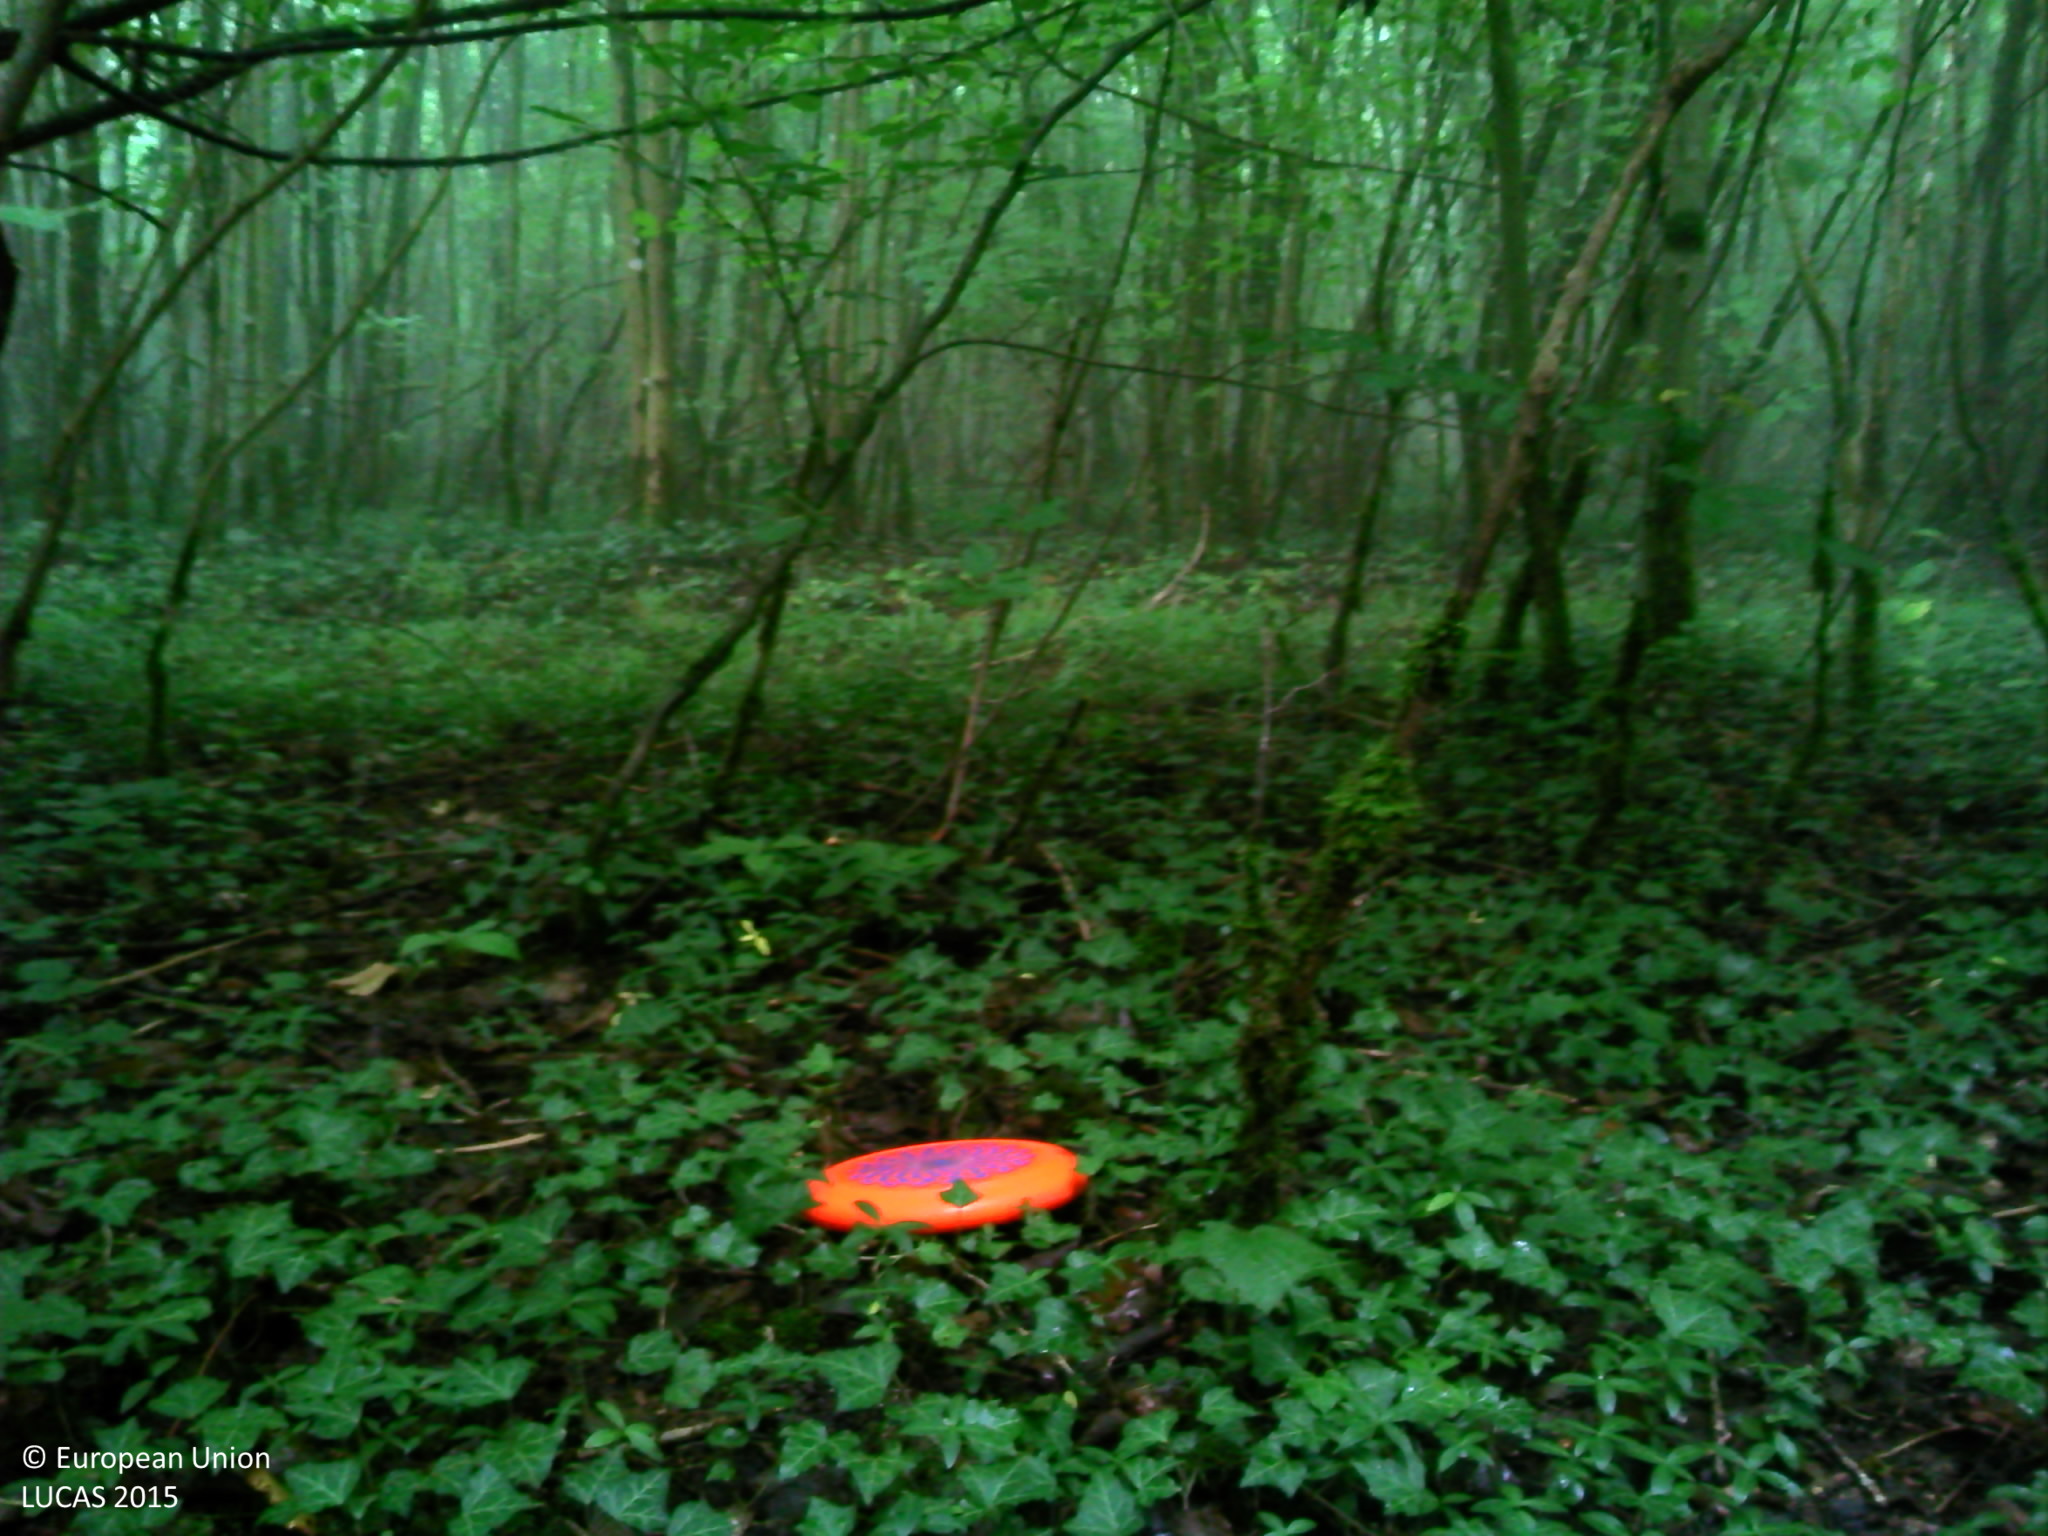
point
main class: Woodland
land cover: Broadleaved woodland
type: mesophytic deciduous forest
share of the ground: > 75 %
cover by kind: broadleaved forest trees 90 %, herbaceous plants 5 %, consolidated bare surface 5 %
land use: Forestry
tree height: > 5 m
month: September
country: FR
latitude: 49.2508
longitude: 6.0291
